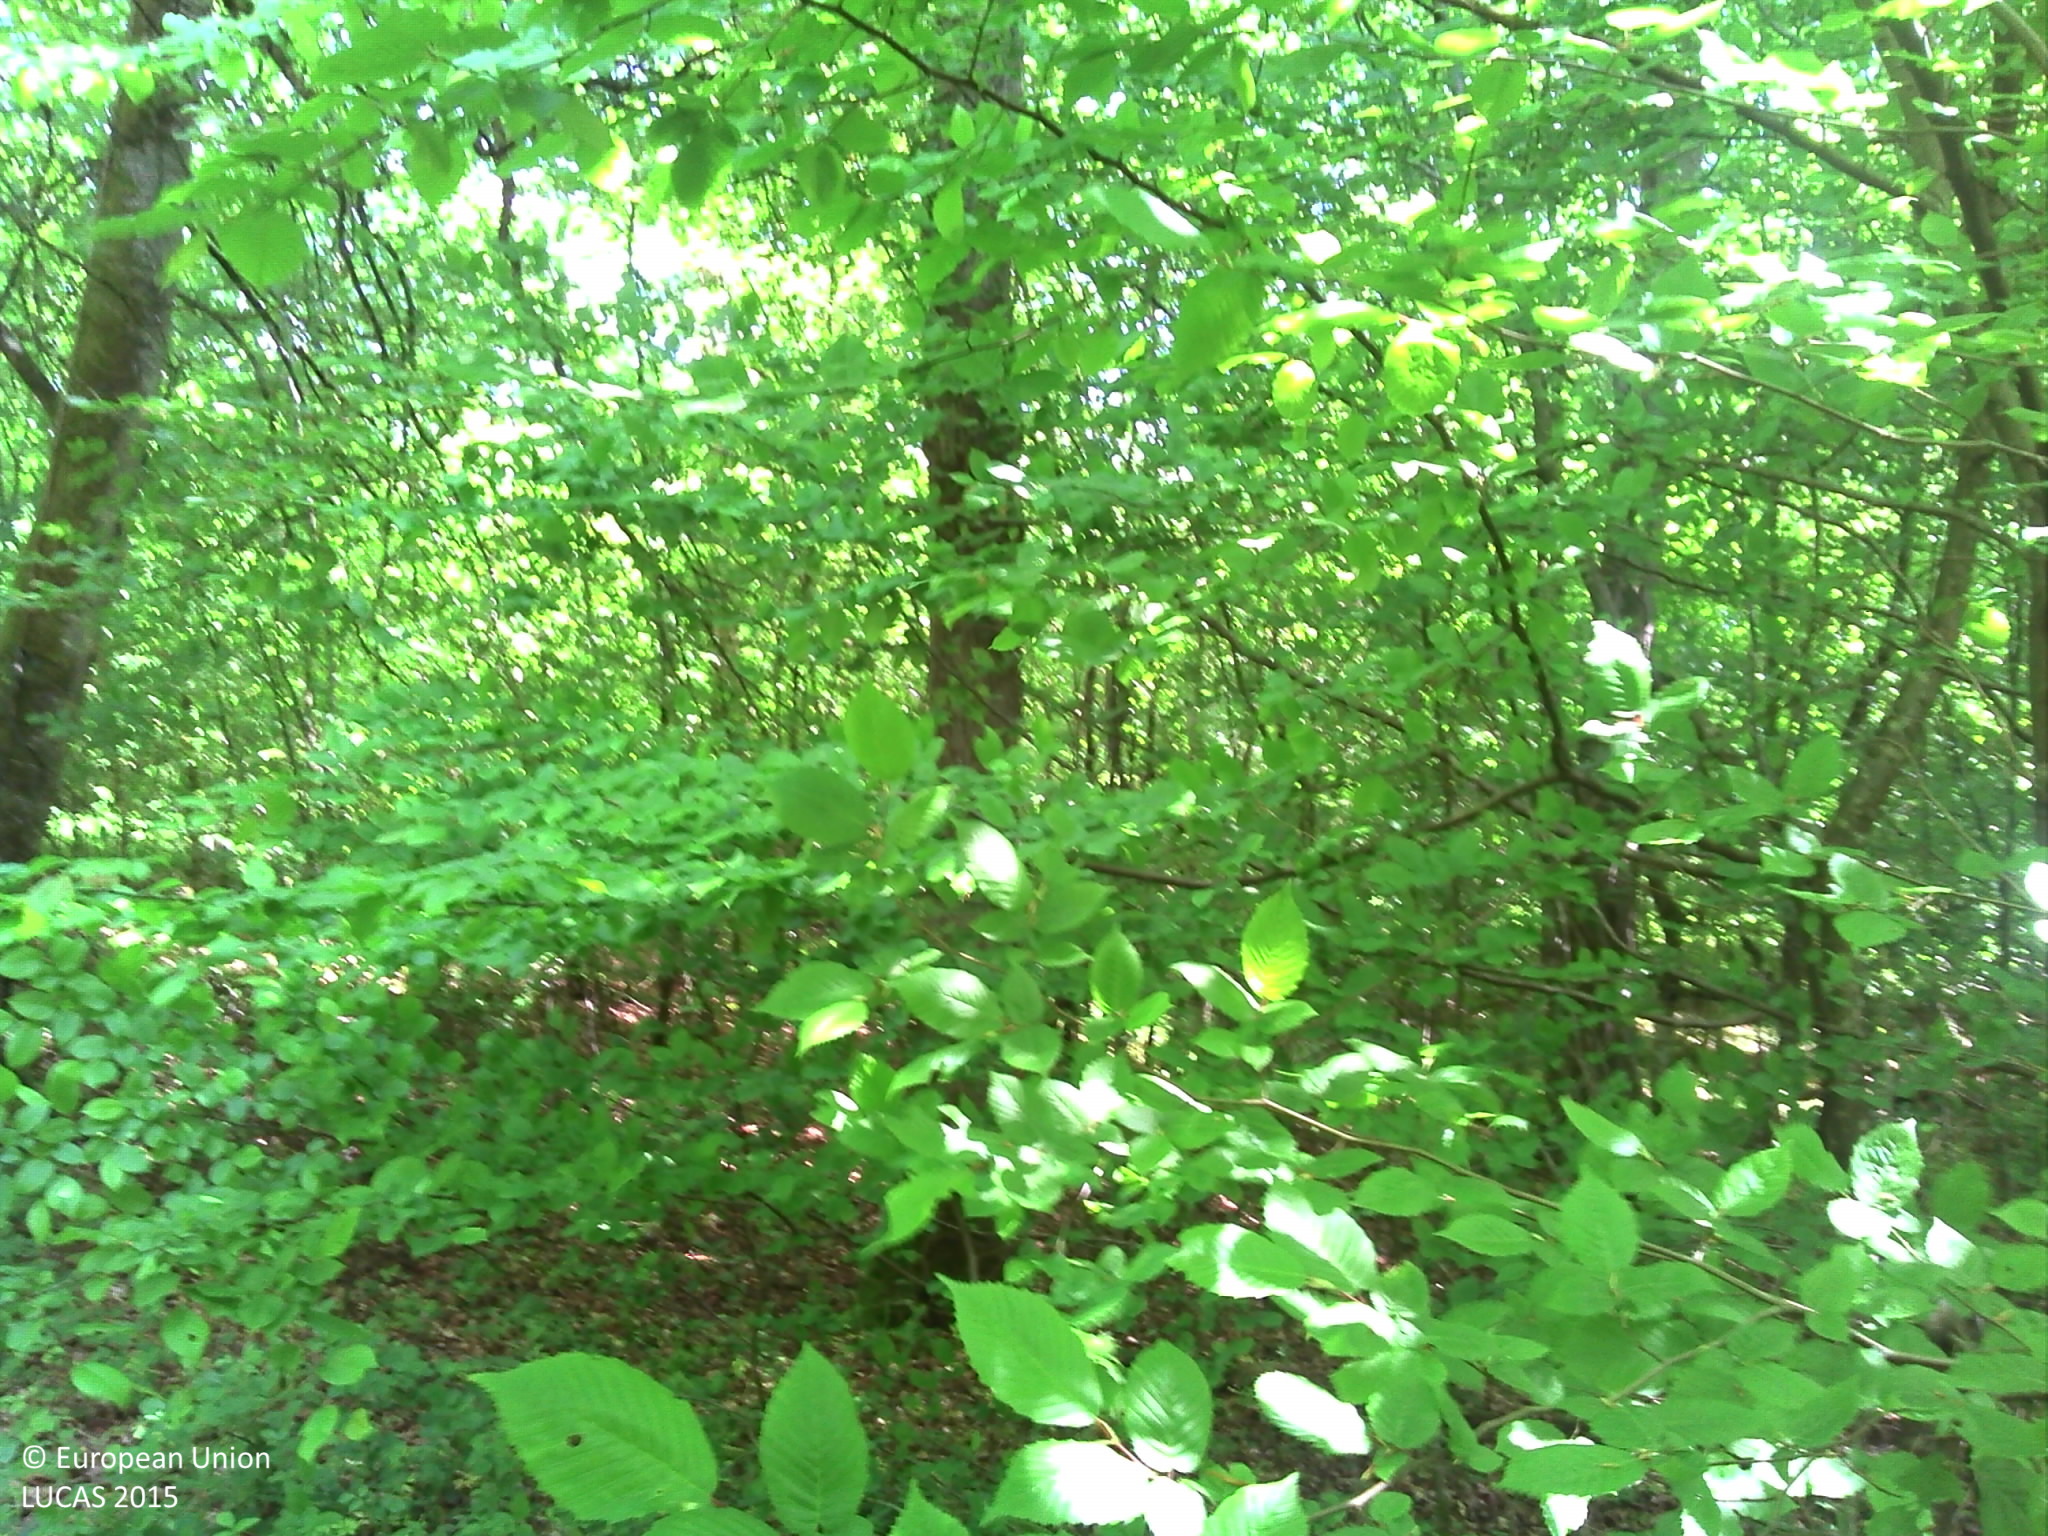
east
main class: Woodland
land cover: Broadleaved woodland
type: acidophilous oak and oak-birch forest
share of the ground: > 75 %
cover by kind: broadleaved forest trees 80 %, herbaceous plants 10 %, lichens and mosses 10 %
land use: Forestry
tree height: > 5 m
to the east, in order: Broadleaved woodland; Spontaneously vegetated surfaces; Tracks; Spontaneously vegetated surfaces; Broadleaved woodland; Grassland without tree/shrub cover; Ditches and canals; Single bushes/trees; Grassland without tree/shrub cover
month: May
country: LU
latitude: 49.6912
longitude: 6.2706
